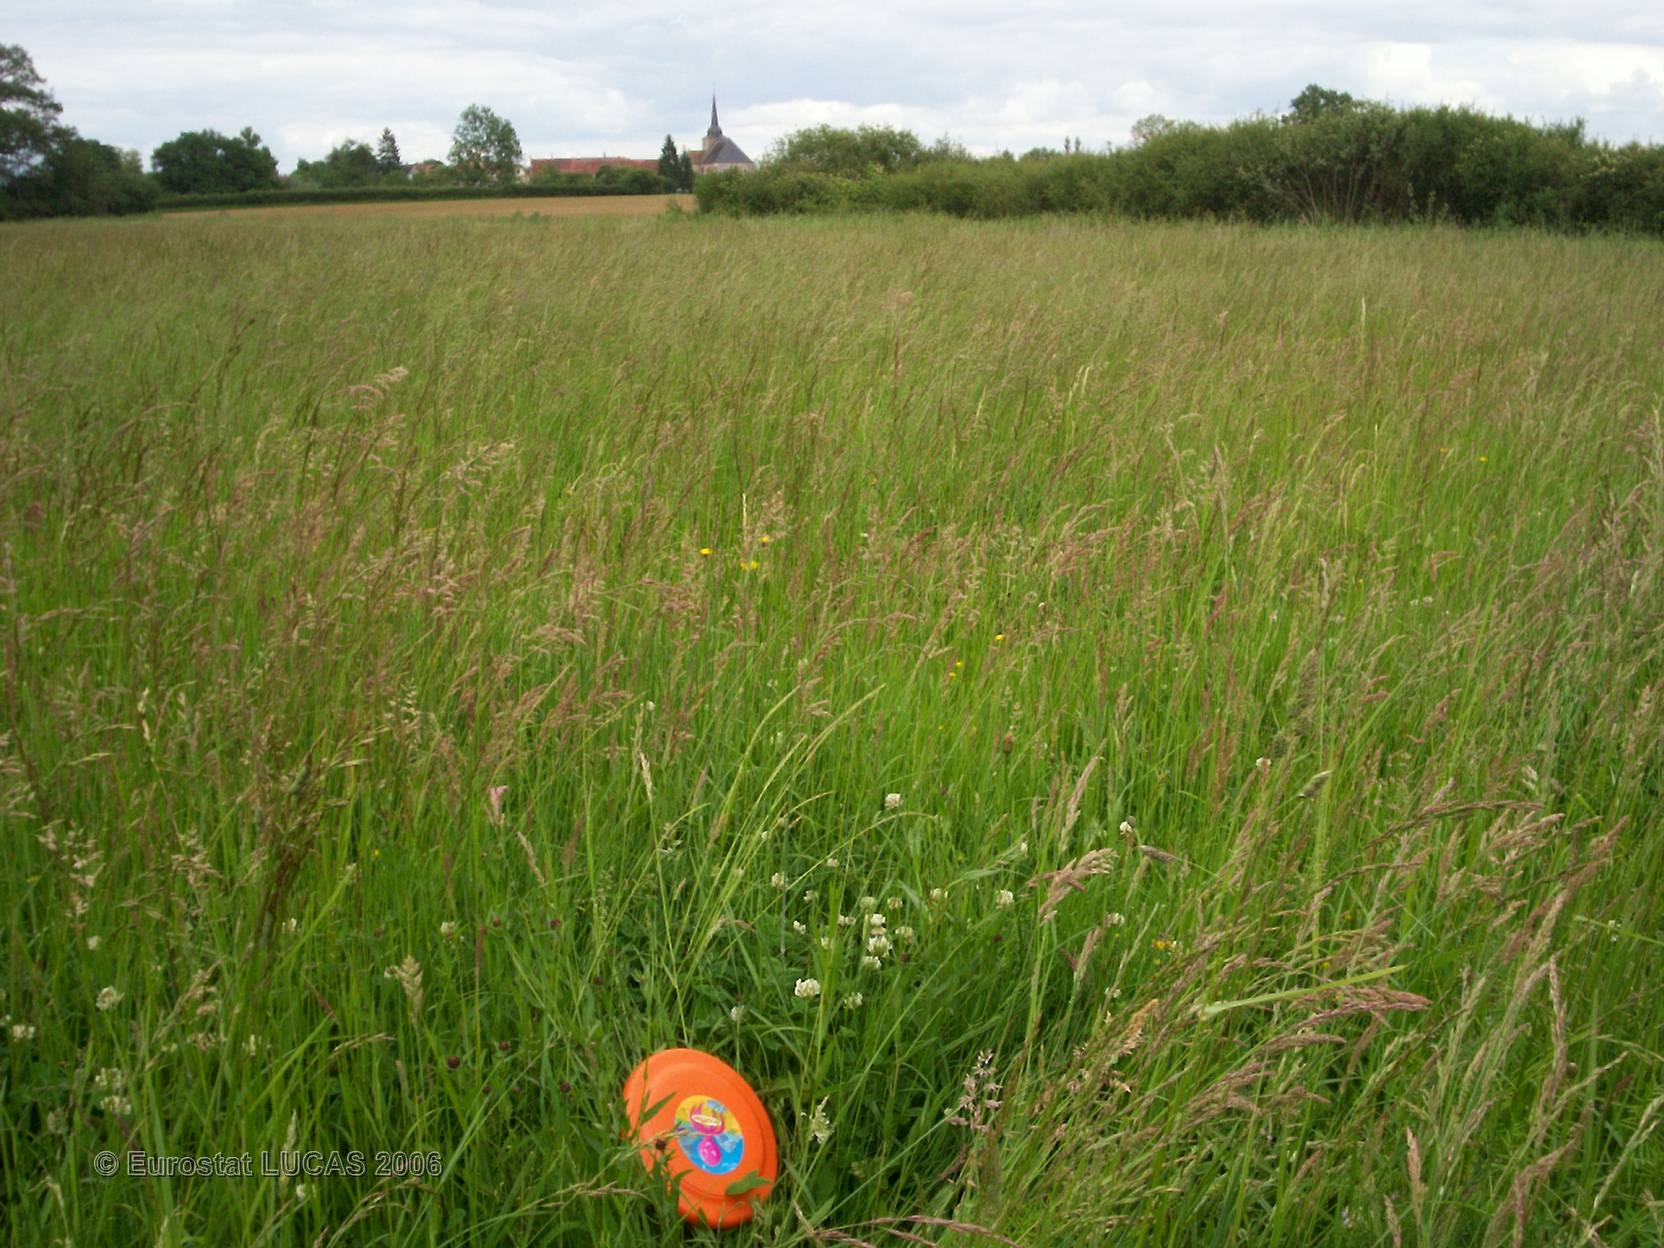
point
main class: Grassland
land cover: Grassland without tree/shrub cover
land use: Agriculture (excluding fallow land and kitchen gardens)
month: May
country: FR
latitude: 46.8648
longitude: 3.0304
